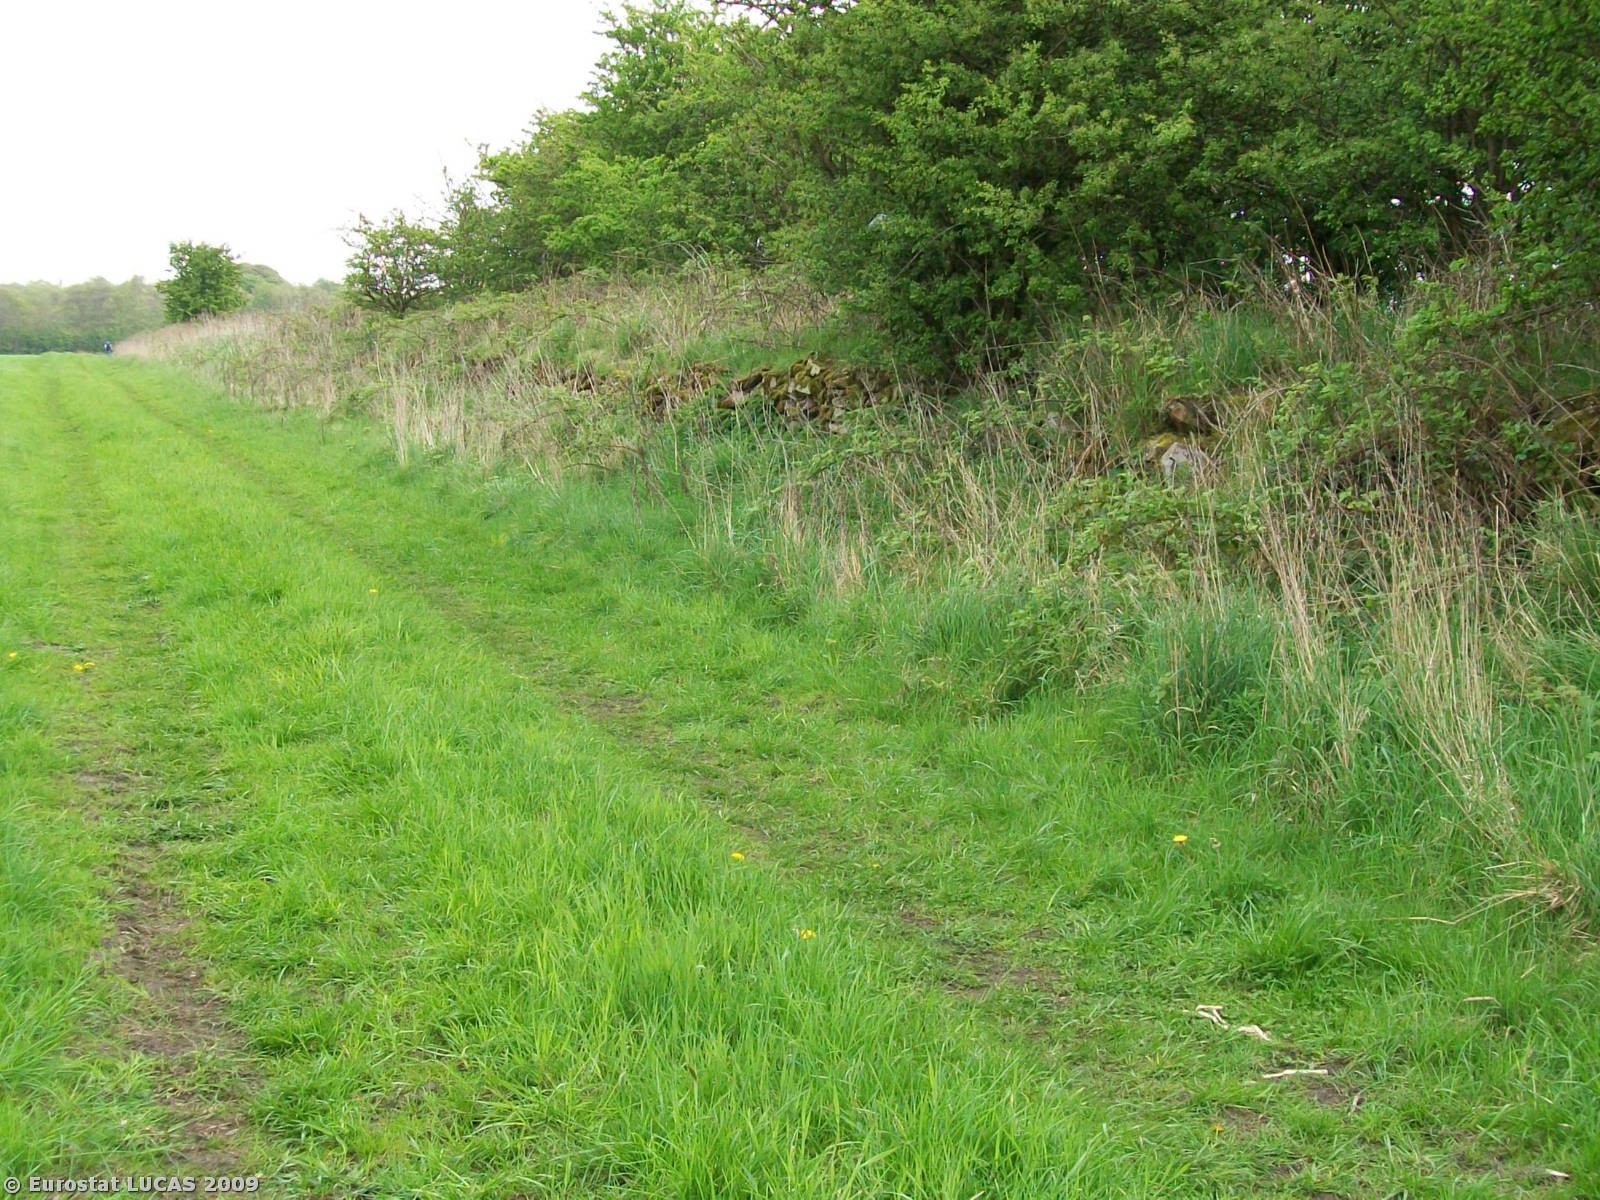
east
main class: Cropland
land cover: Common wheat
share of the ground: 50 - 75 %
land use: Agriculture (excluding fallow land and kitchen gardens)
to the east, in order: Common wheat; Grass margins; Abandoned hedges; Fences; Potatoes
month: April
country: GB
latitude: 53.5366
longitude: -2.8207
